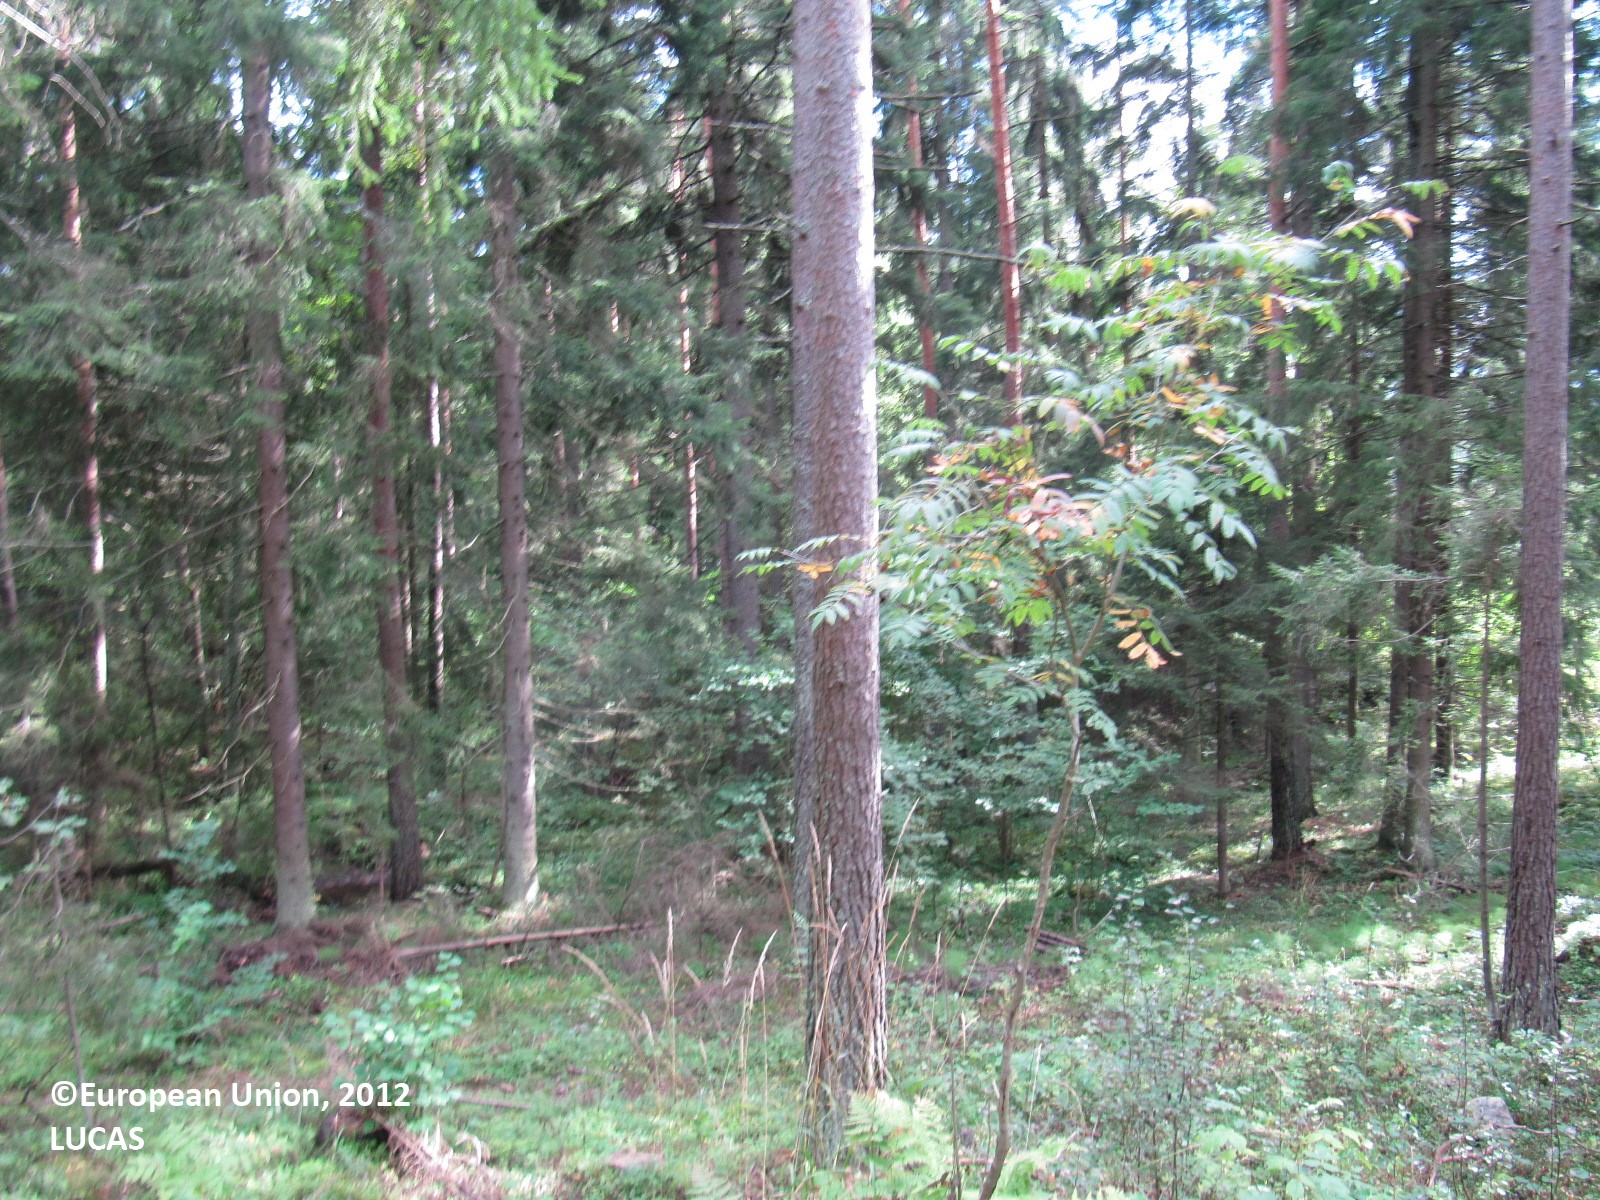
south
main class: Woodland
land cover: Spruce dominated mixed woodland
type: boreal forest
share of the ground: 50 - 75 %
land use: Forestry
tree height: > 5 m
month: August
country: FI
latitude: 60.2166
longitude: 24.1240
